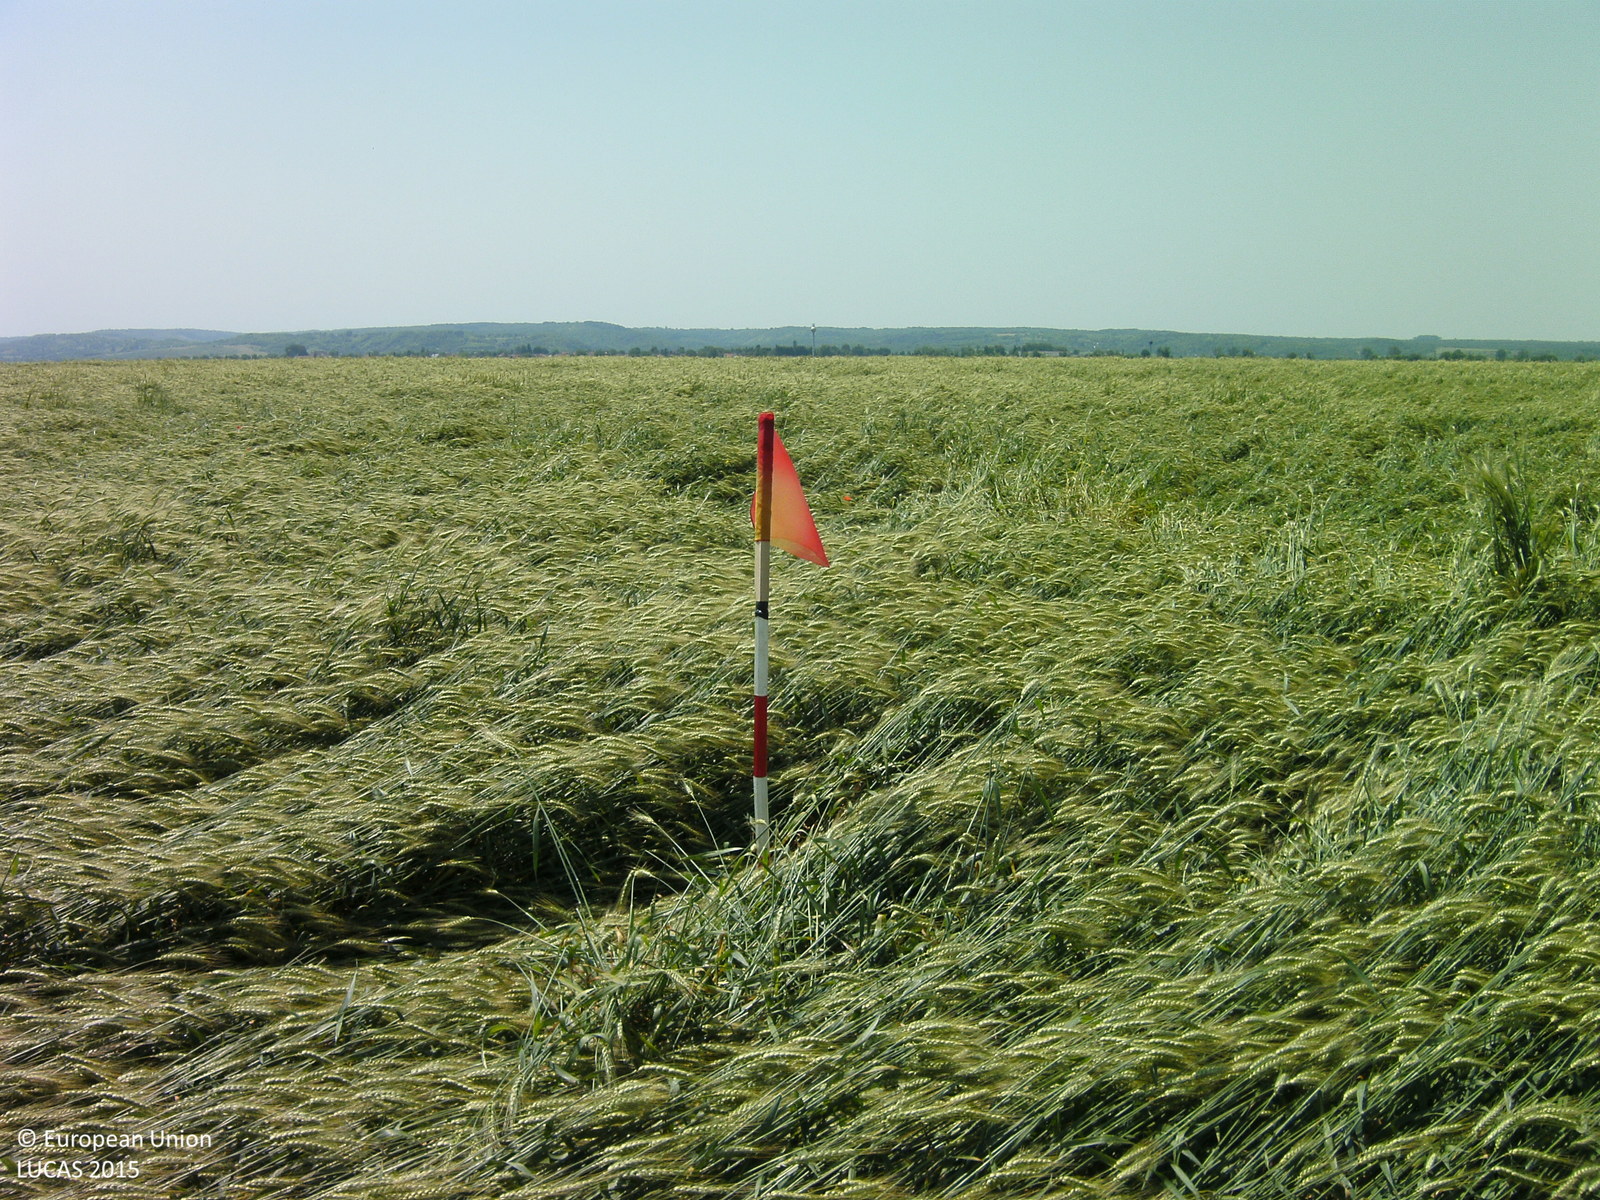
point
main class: Cropland
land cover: Common wheat
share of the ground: > 75 %
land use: Agriculture (excluding fallow land and kitchen gardens)
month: June
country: HU
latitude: 46.3787
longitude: 17.9767
